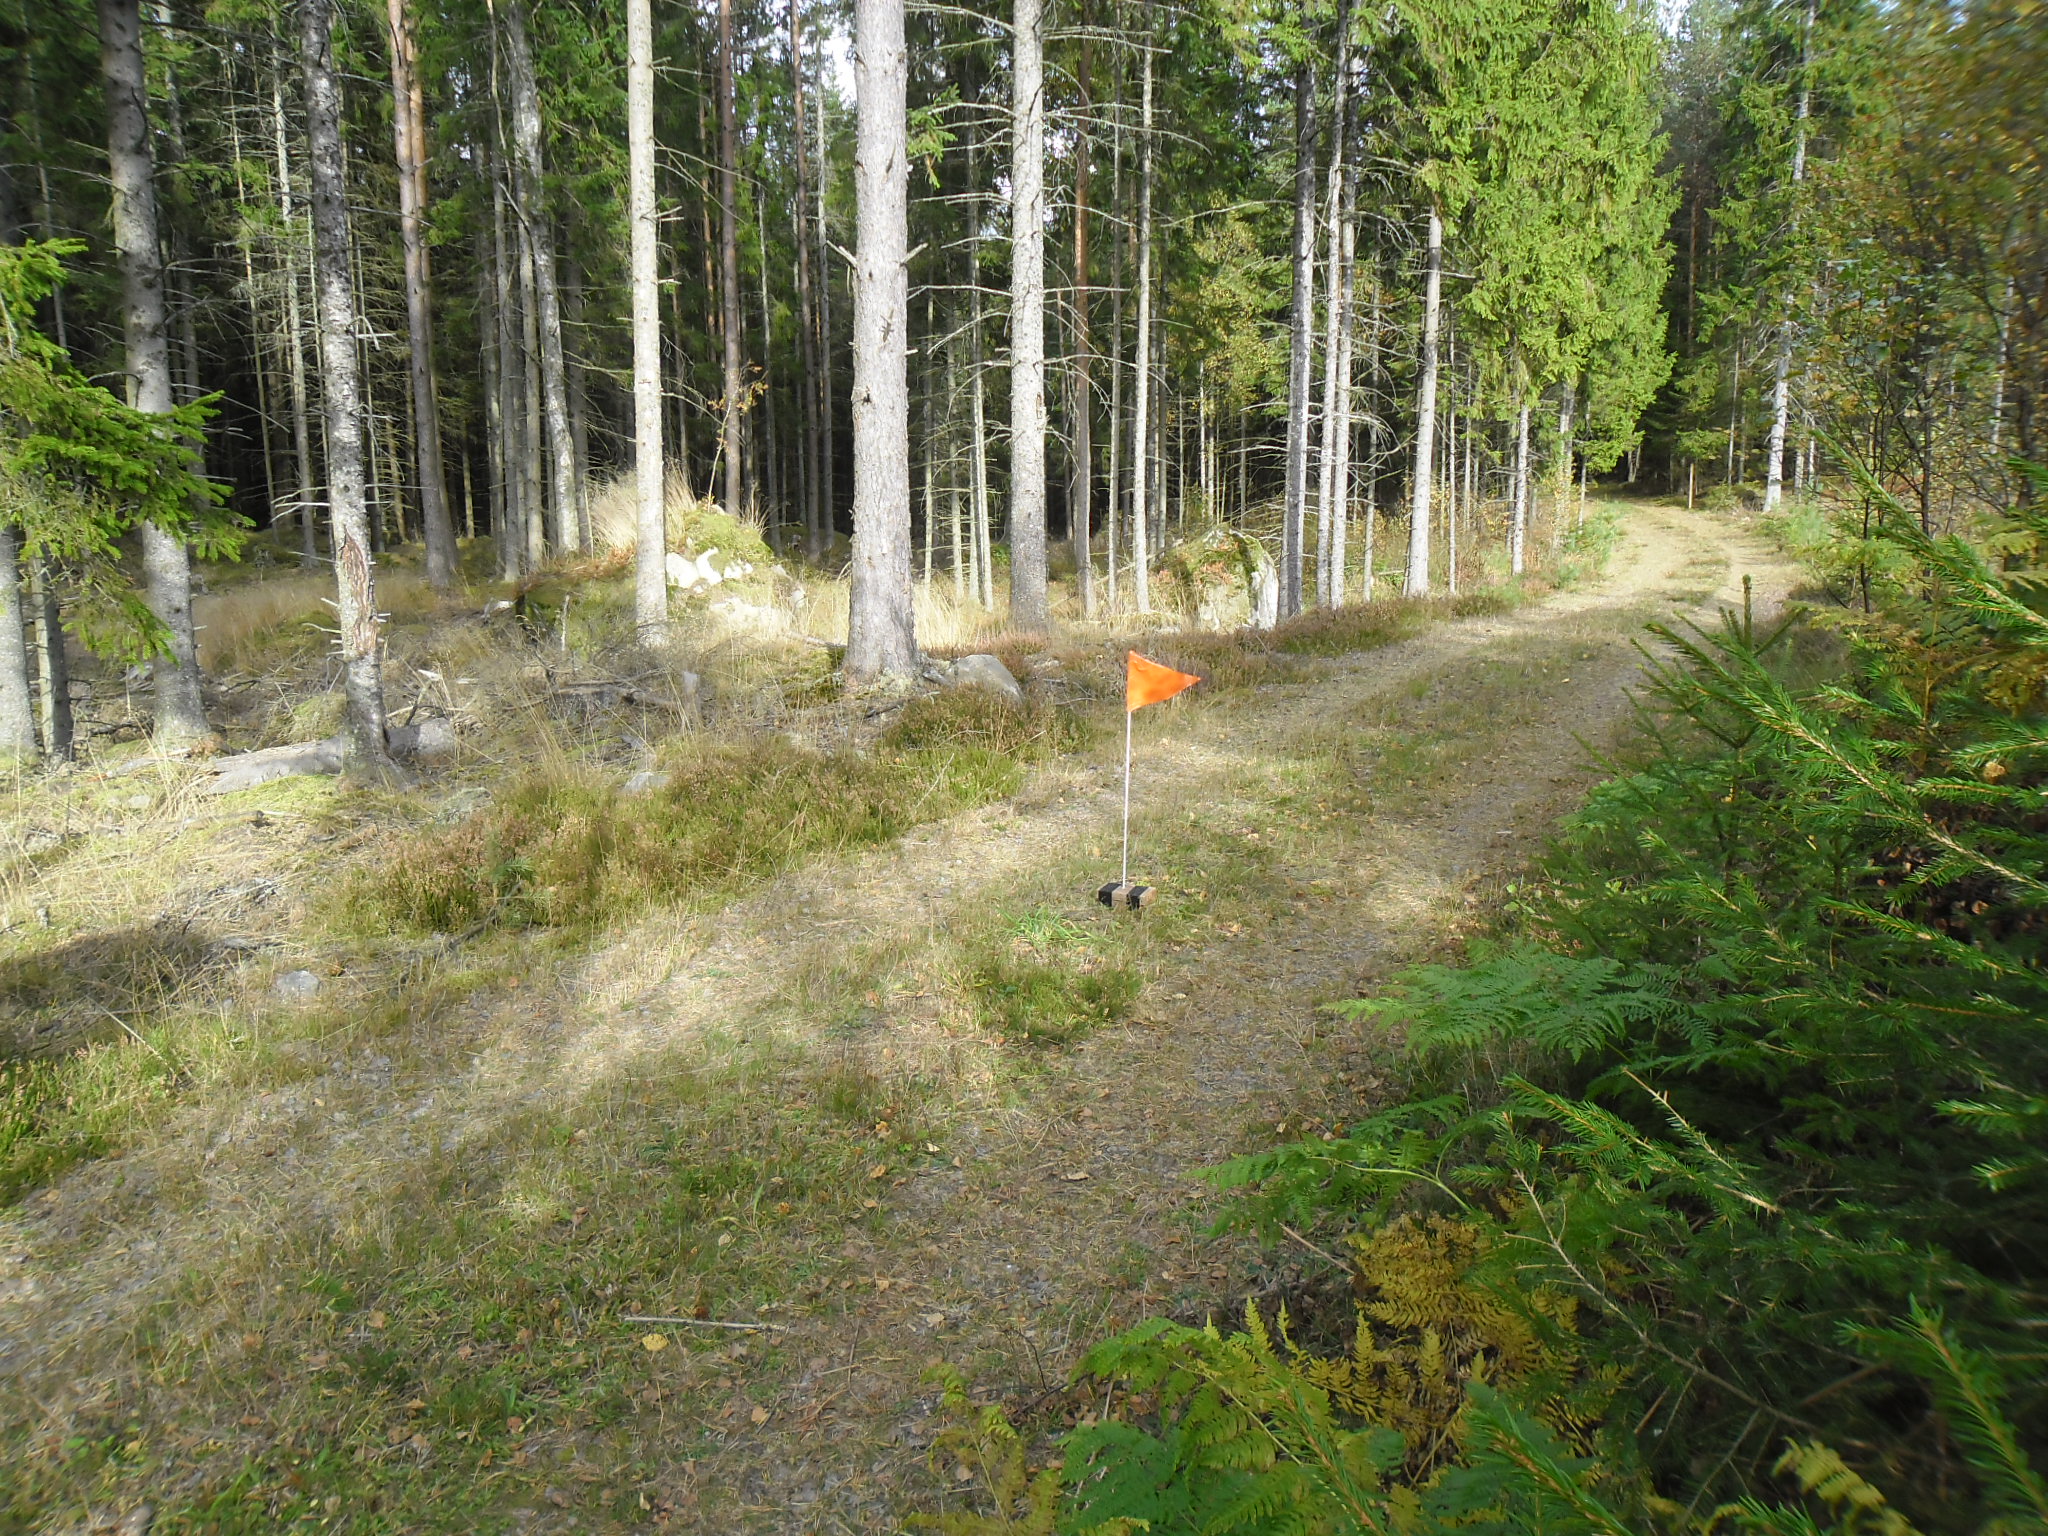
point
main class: Woodland
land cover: Spruce dominated coniferous woodland
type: boreal forest
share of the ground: > 75 %
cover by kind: coniferous forest trees 70 %, herbaceous plants 15 %, lichens and mosses 15 %
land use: Forestry
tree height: > 5 m
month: October
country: SE
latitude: 56.4193
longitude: 13.8067
